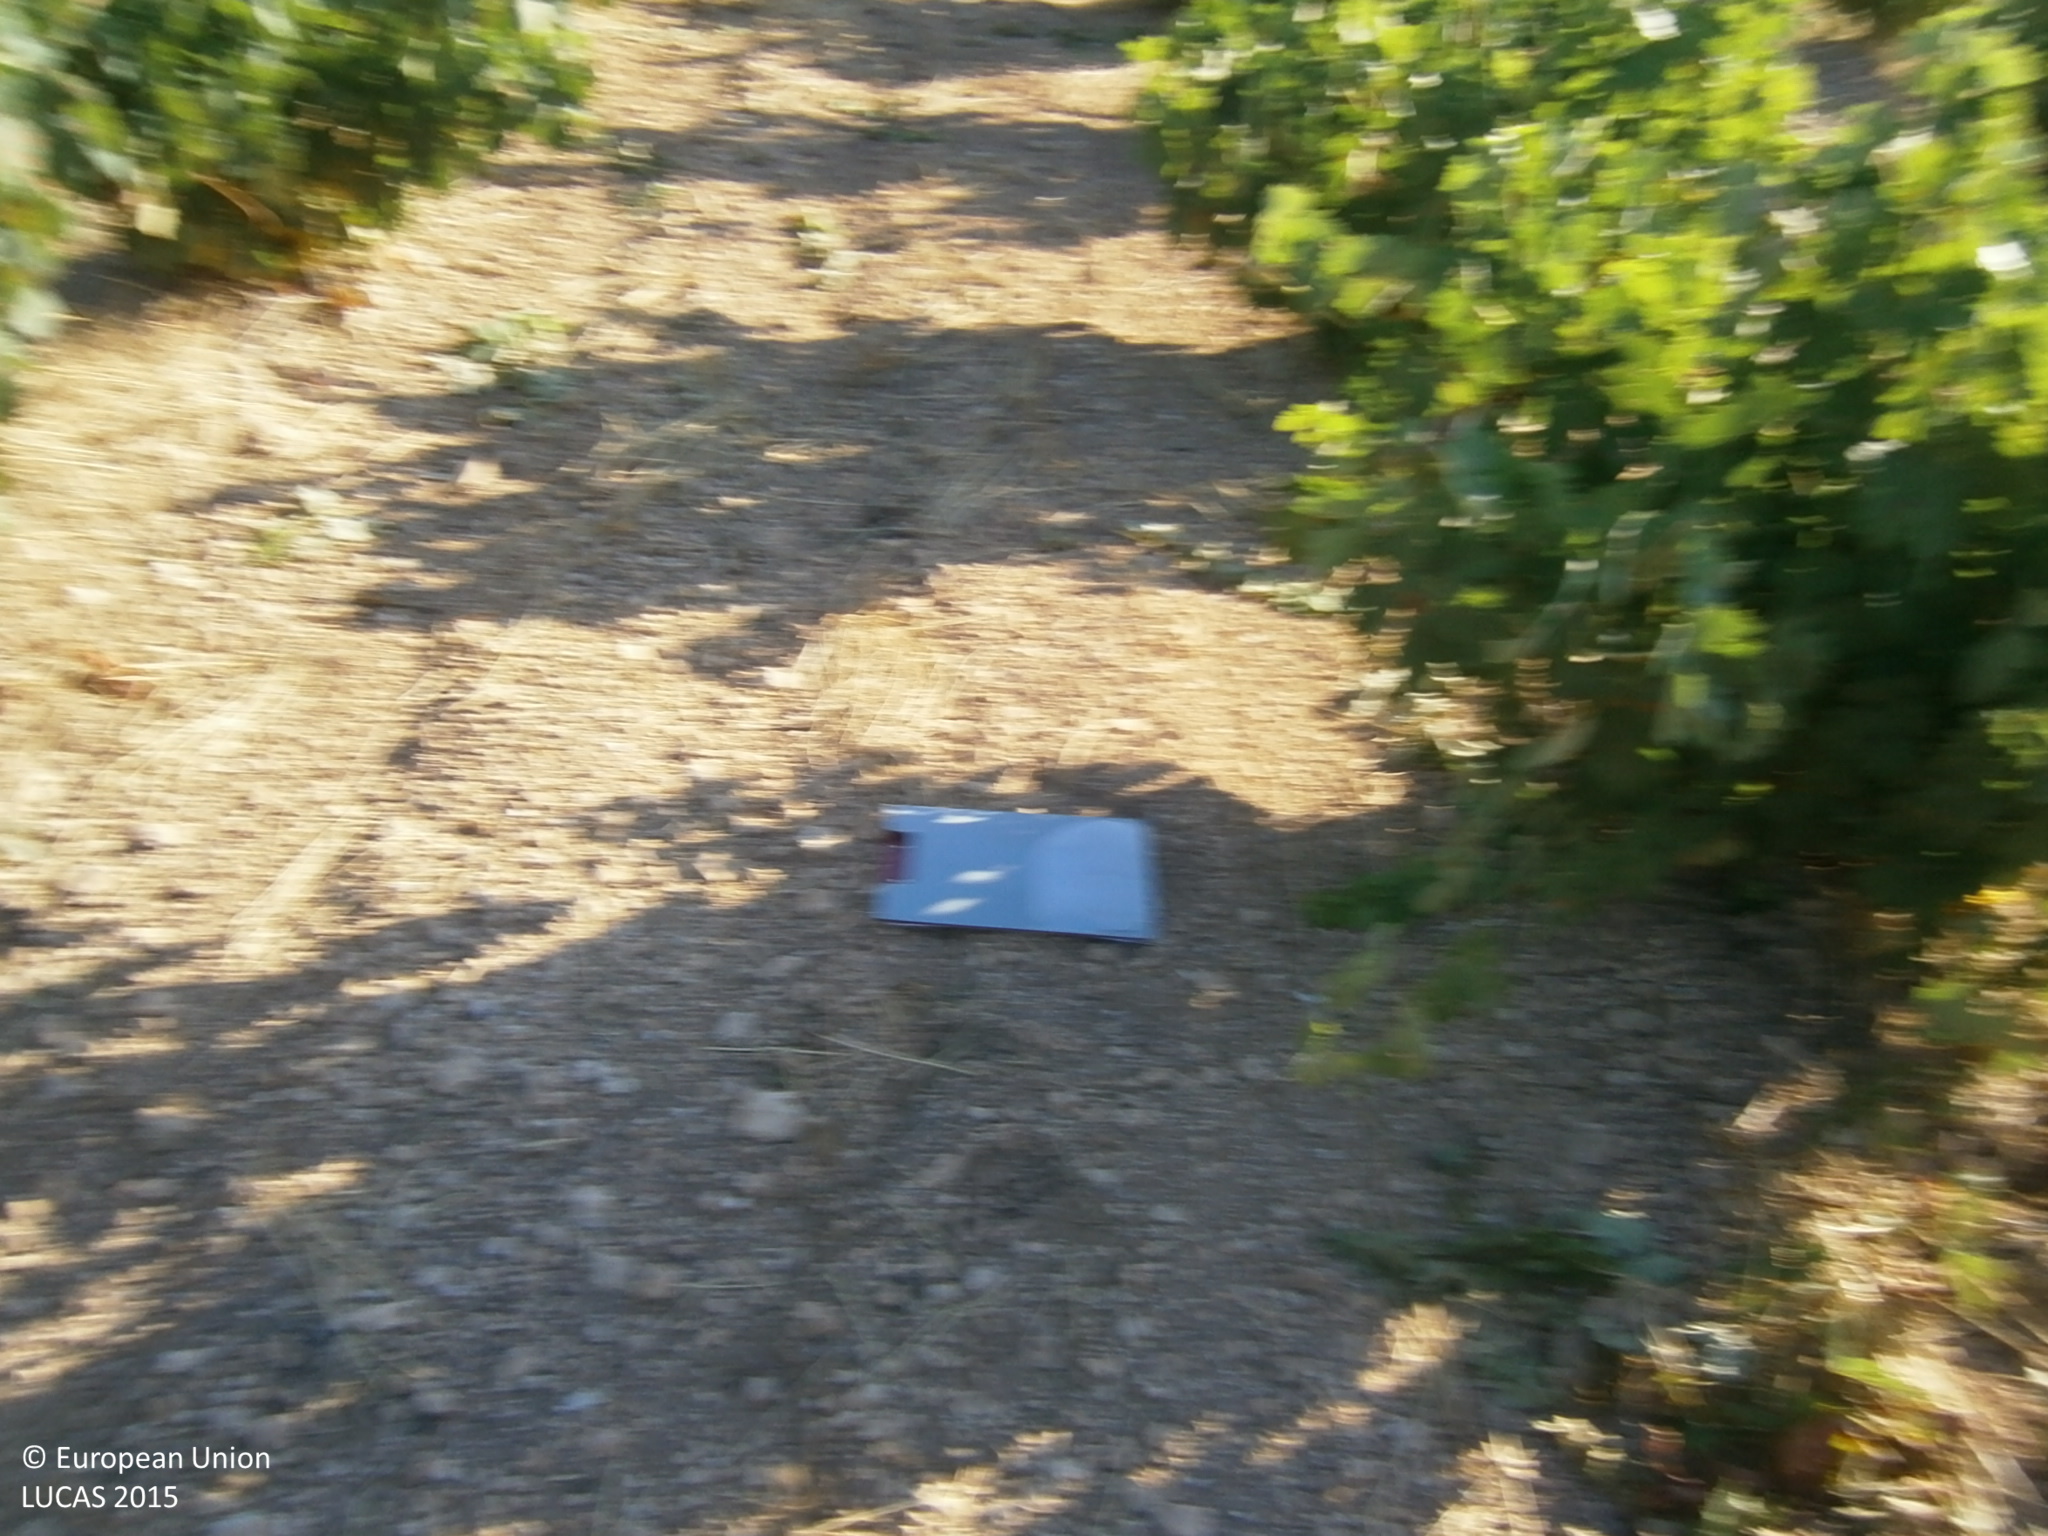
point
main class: Cropland
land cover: Vineyards
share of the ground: 25 - 50 %
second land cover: Other bare soil
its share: > 75 %
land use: Agriculture (excluding fallow land and kitchen gardens)
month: June
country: ES
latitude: 38.8194
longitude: -6.5179
